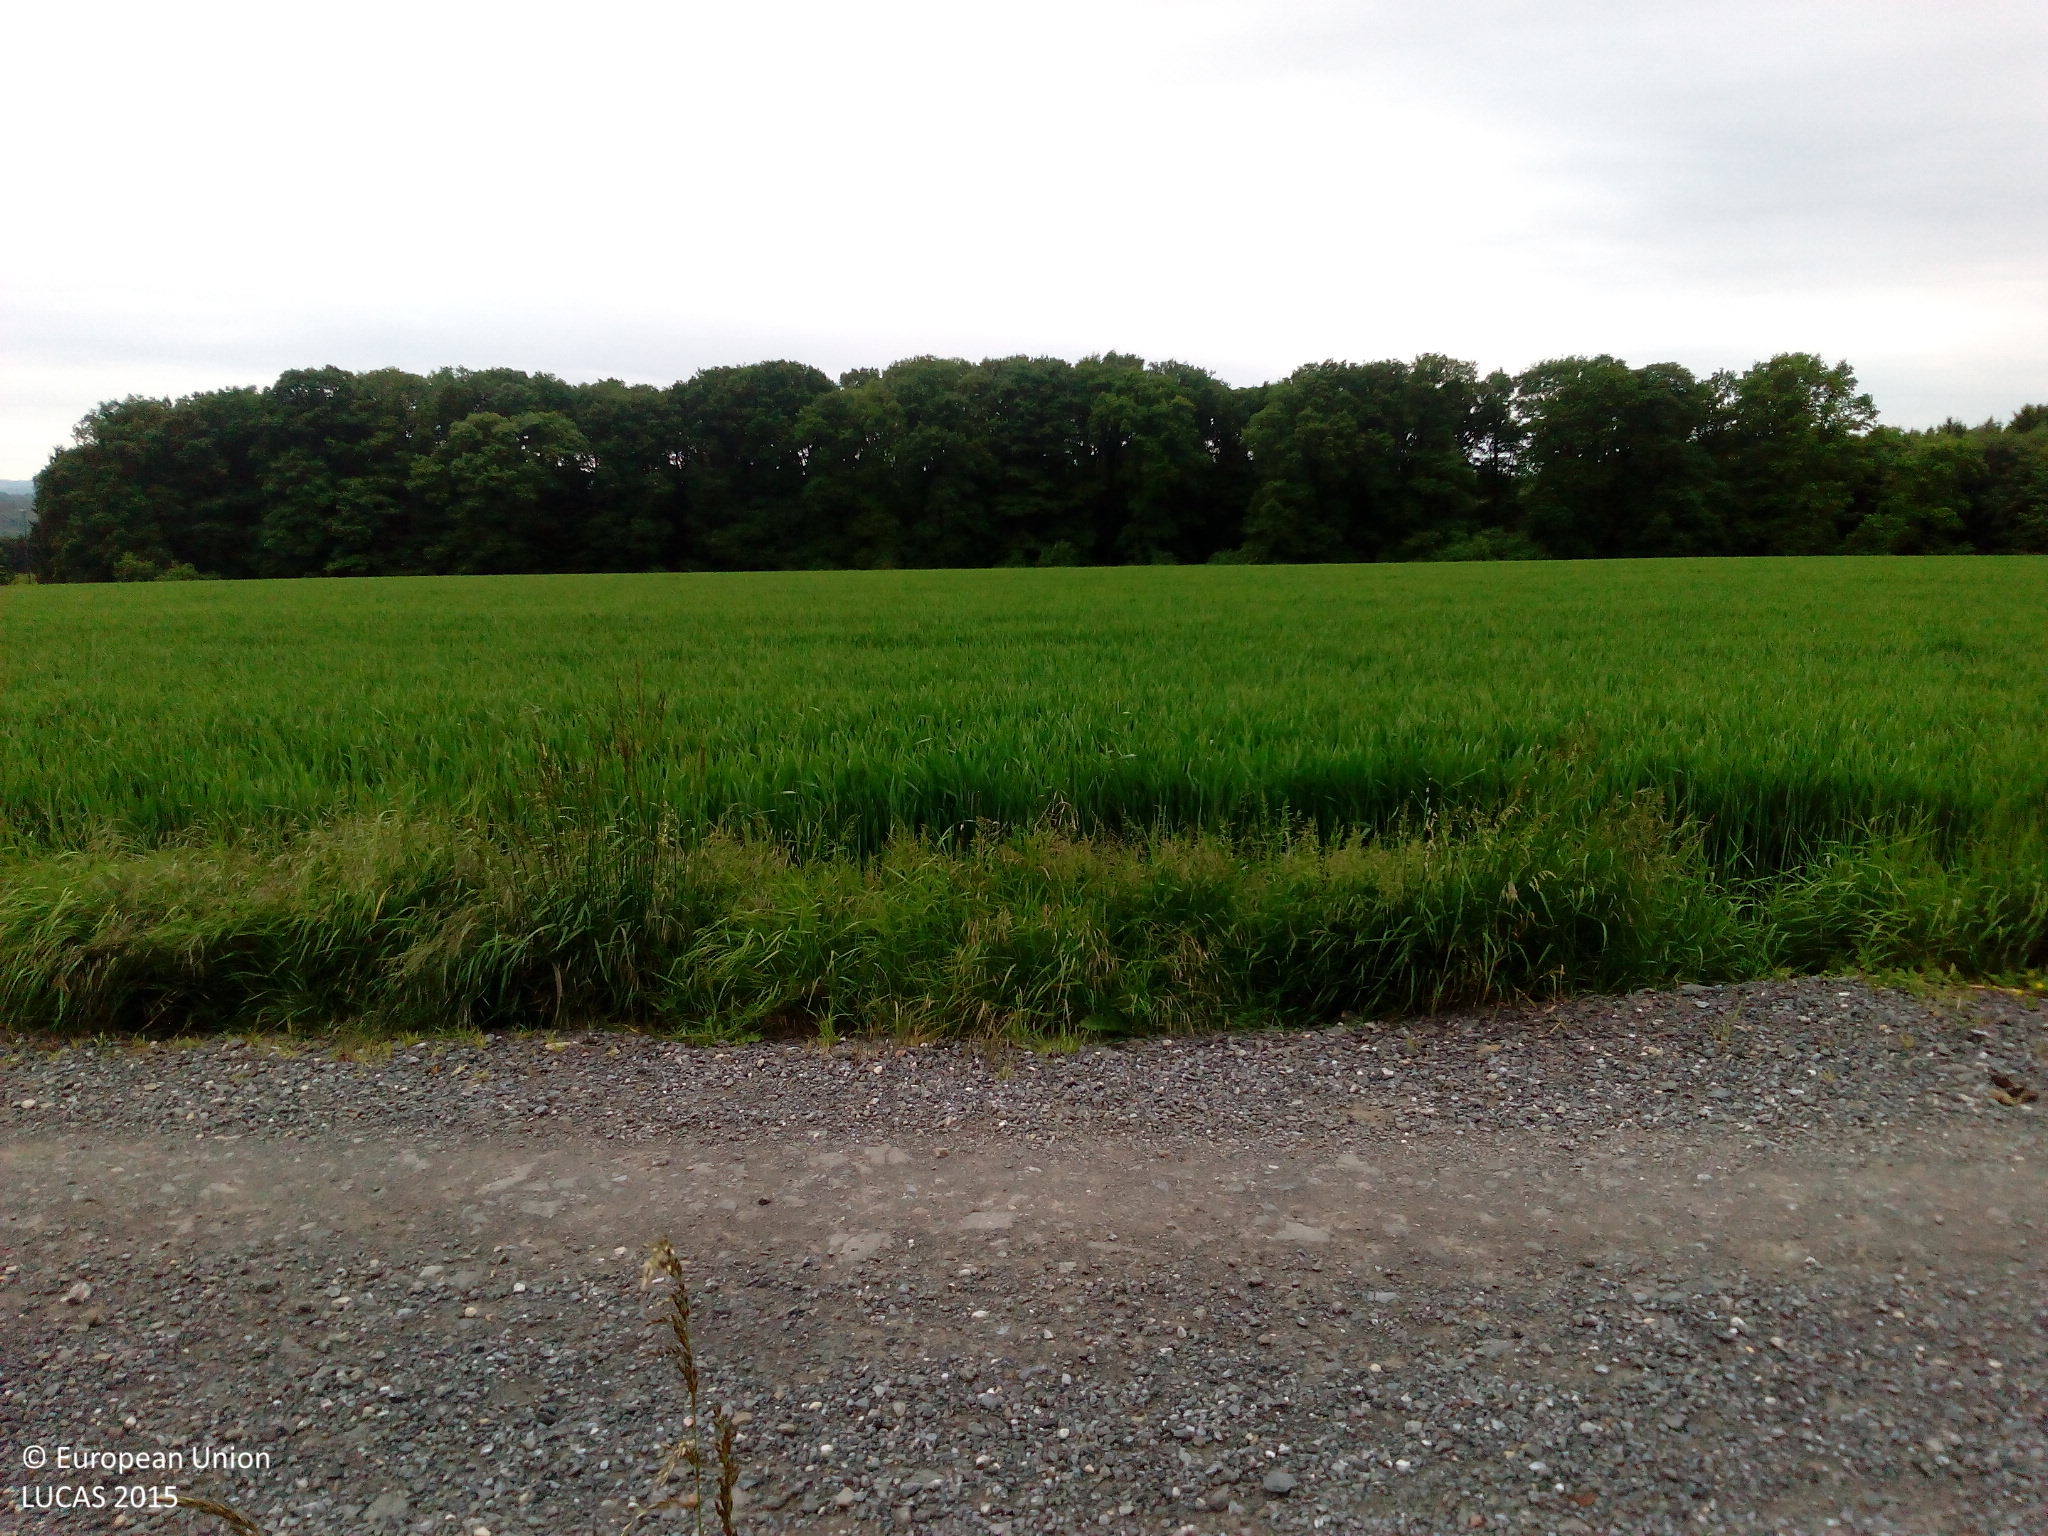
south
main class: Cropland
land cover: Rape and turnip rape
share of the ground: > 75 %
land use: Agriculture (excluding fallow land and kitchen gardens)
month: June
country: DE
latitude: 51.4791
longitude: 7.9701
